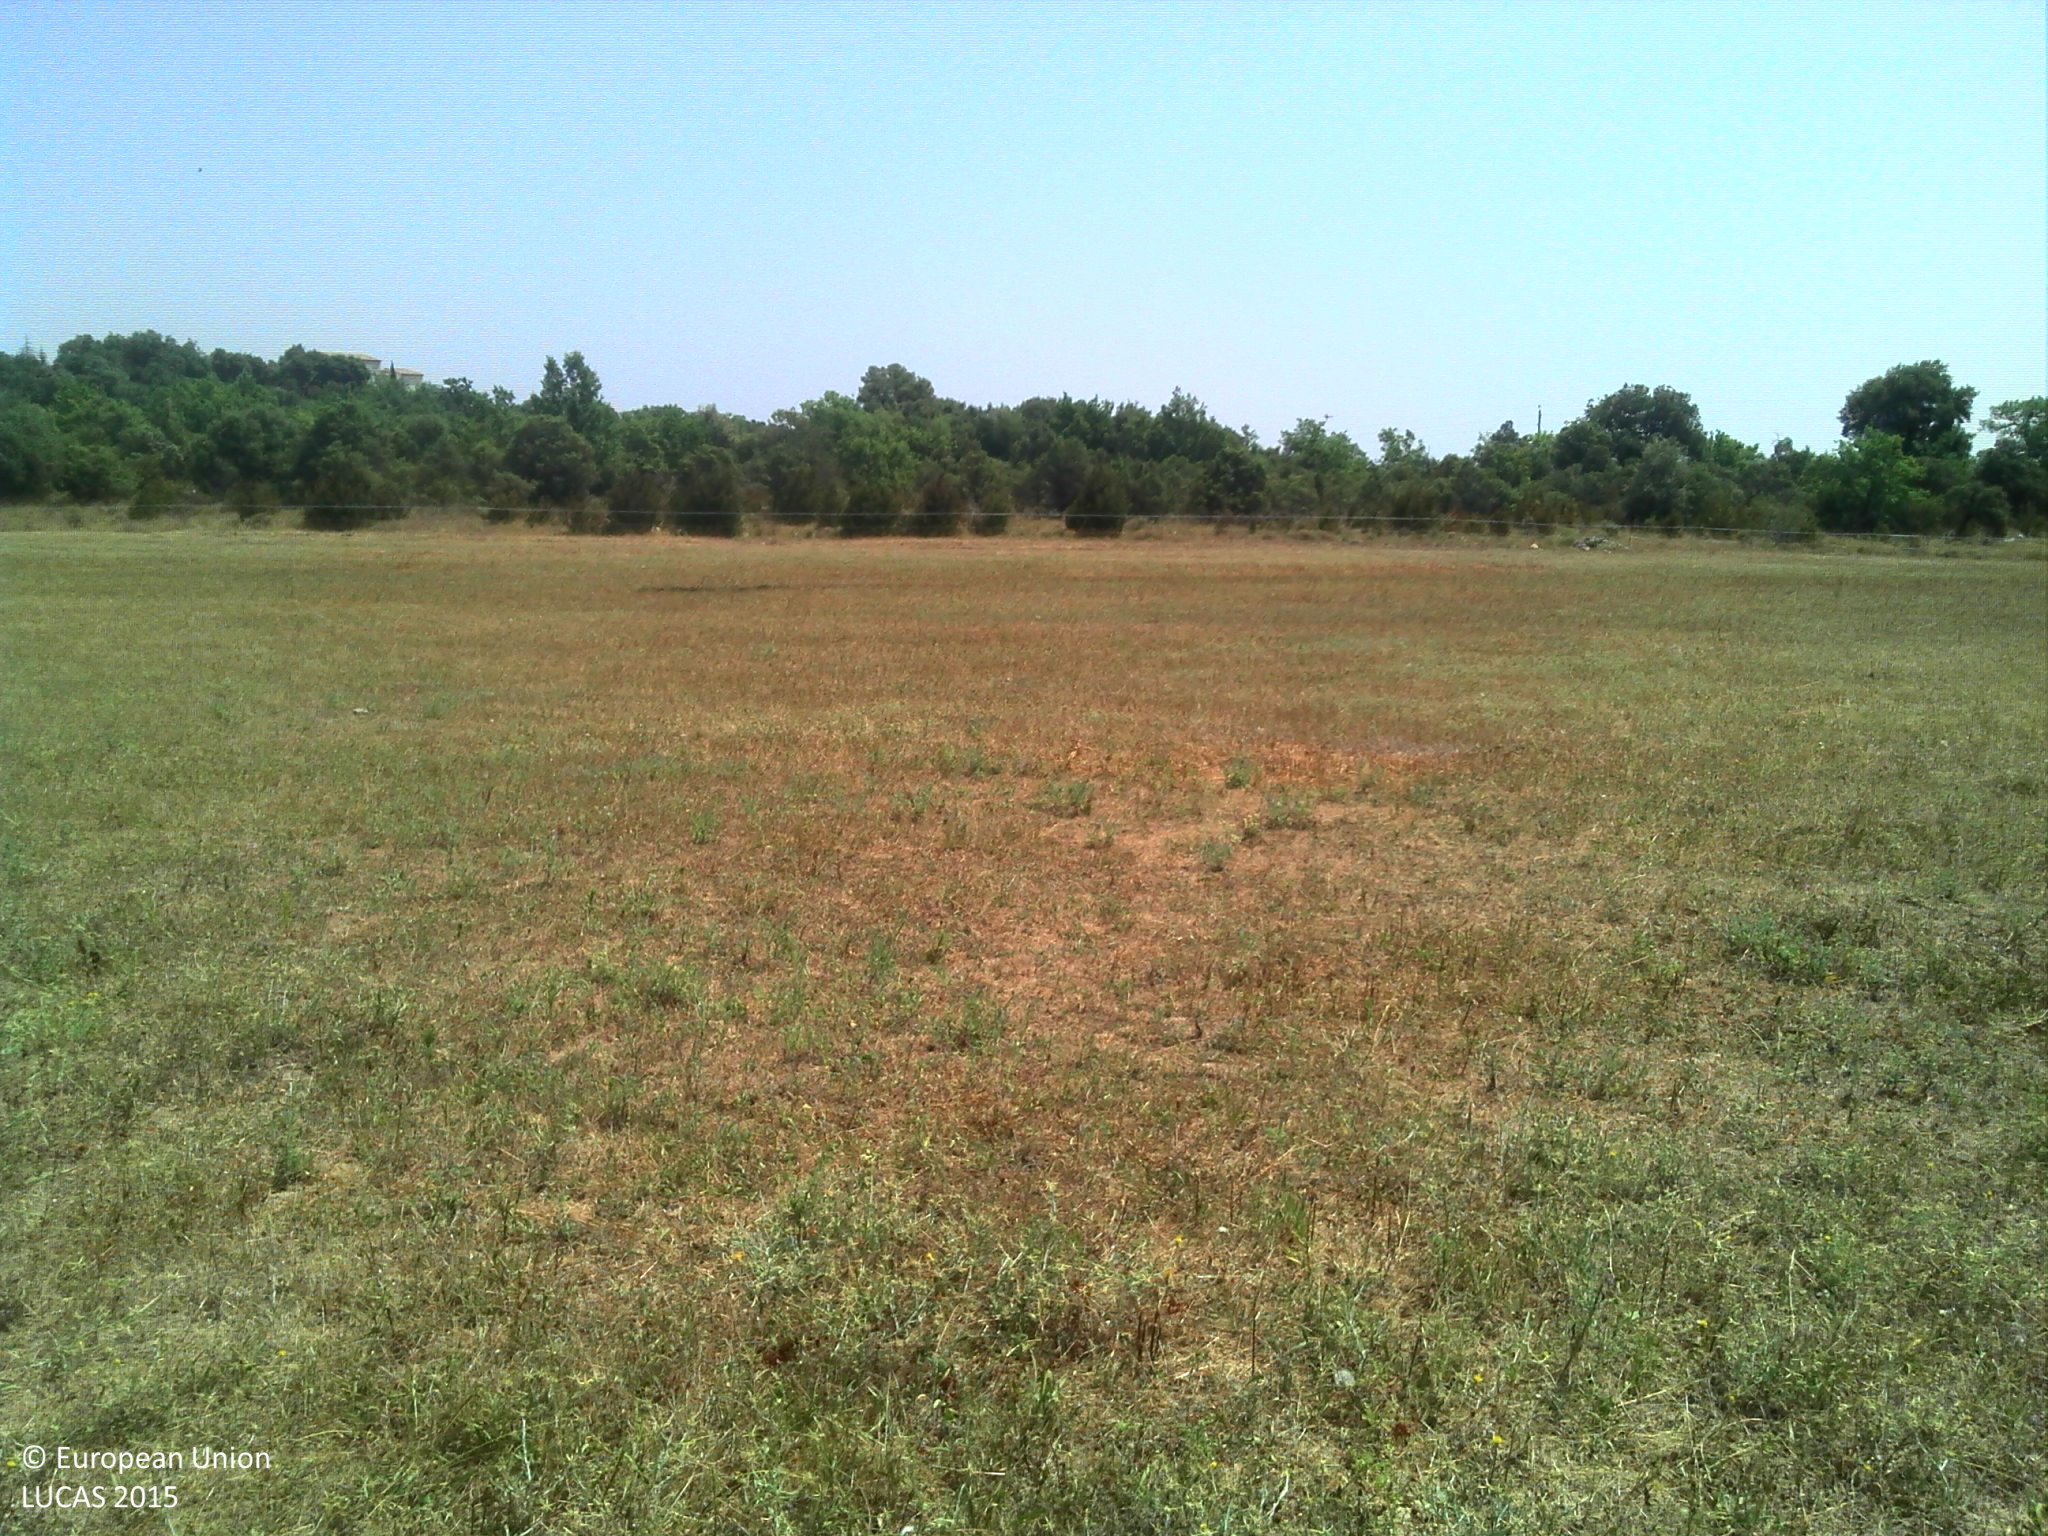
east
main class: Grassland
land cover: Grassland without tree/shrub cover
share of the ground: > 75 %
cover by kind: herbaceous plants 100 %
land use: Sport
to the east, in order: Grassland without tree/shrub cover; Fences; Shrubland with sparse tree cover; Tracks; Shrubland with sparse tree cover; Electric lines; Shrubland with sparse tree cover
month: July
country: FR
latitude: 44.3371
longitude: 4.2753
